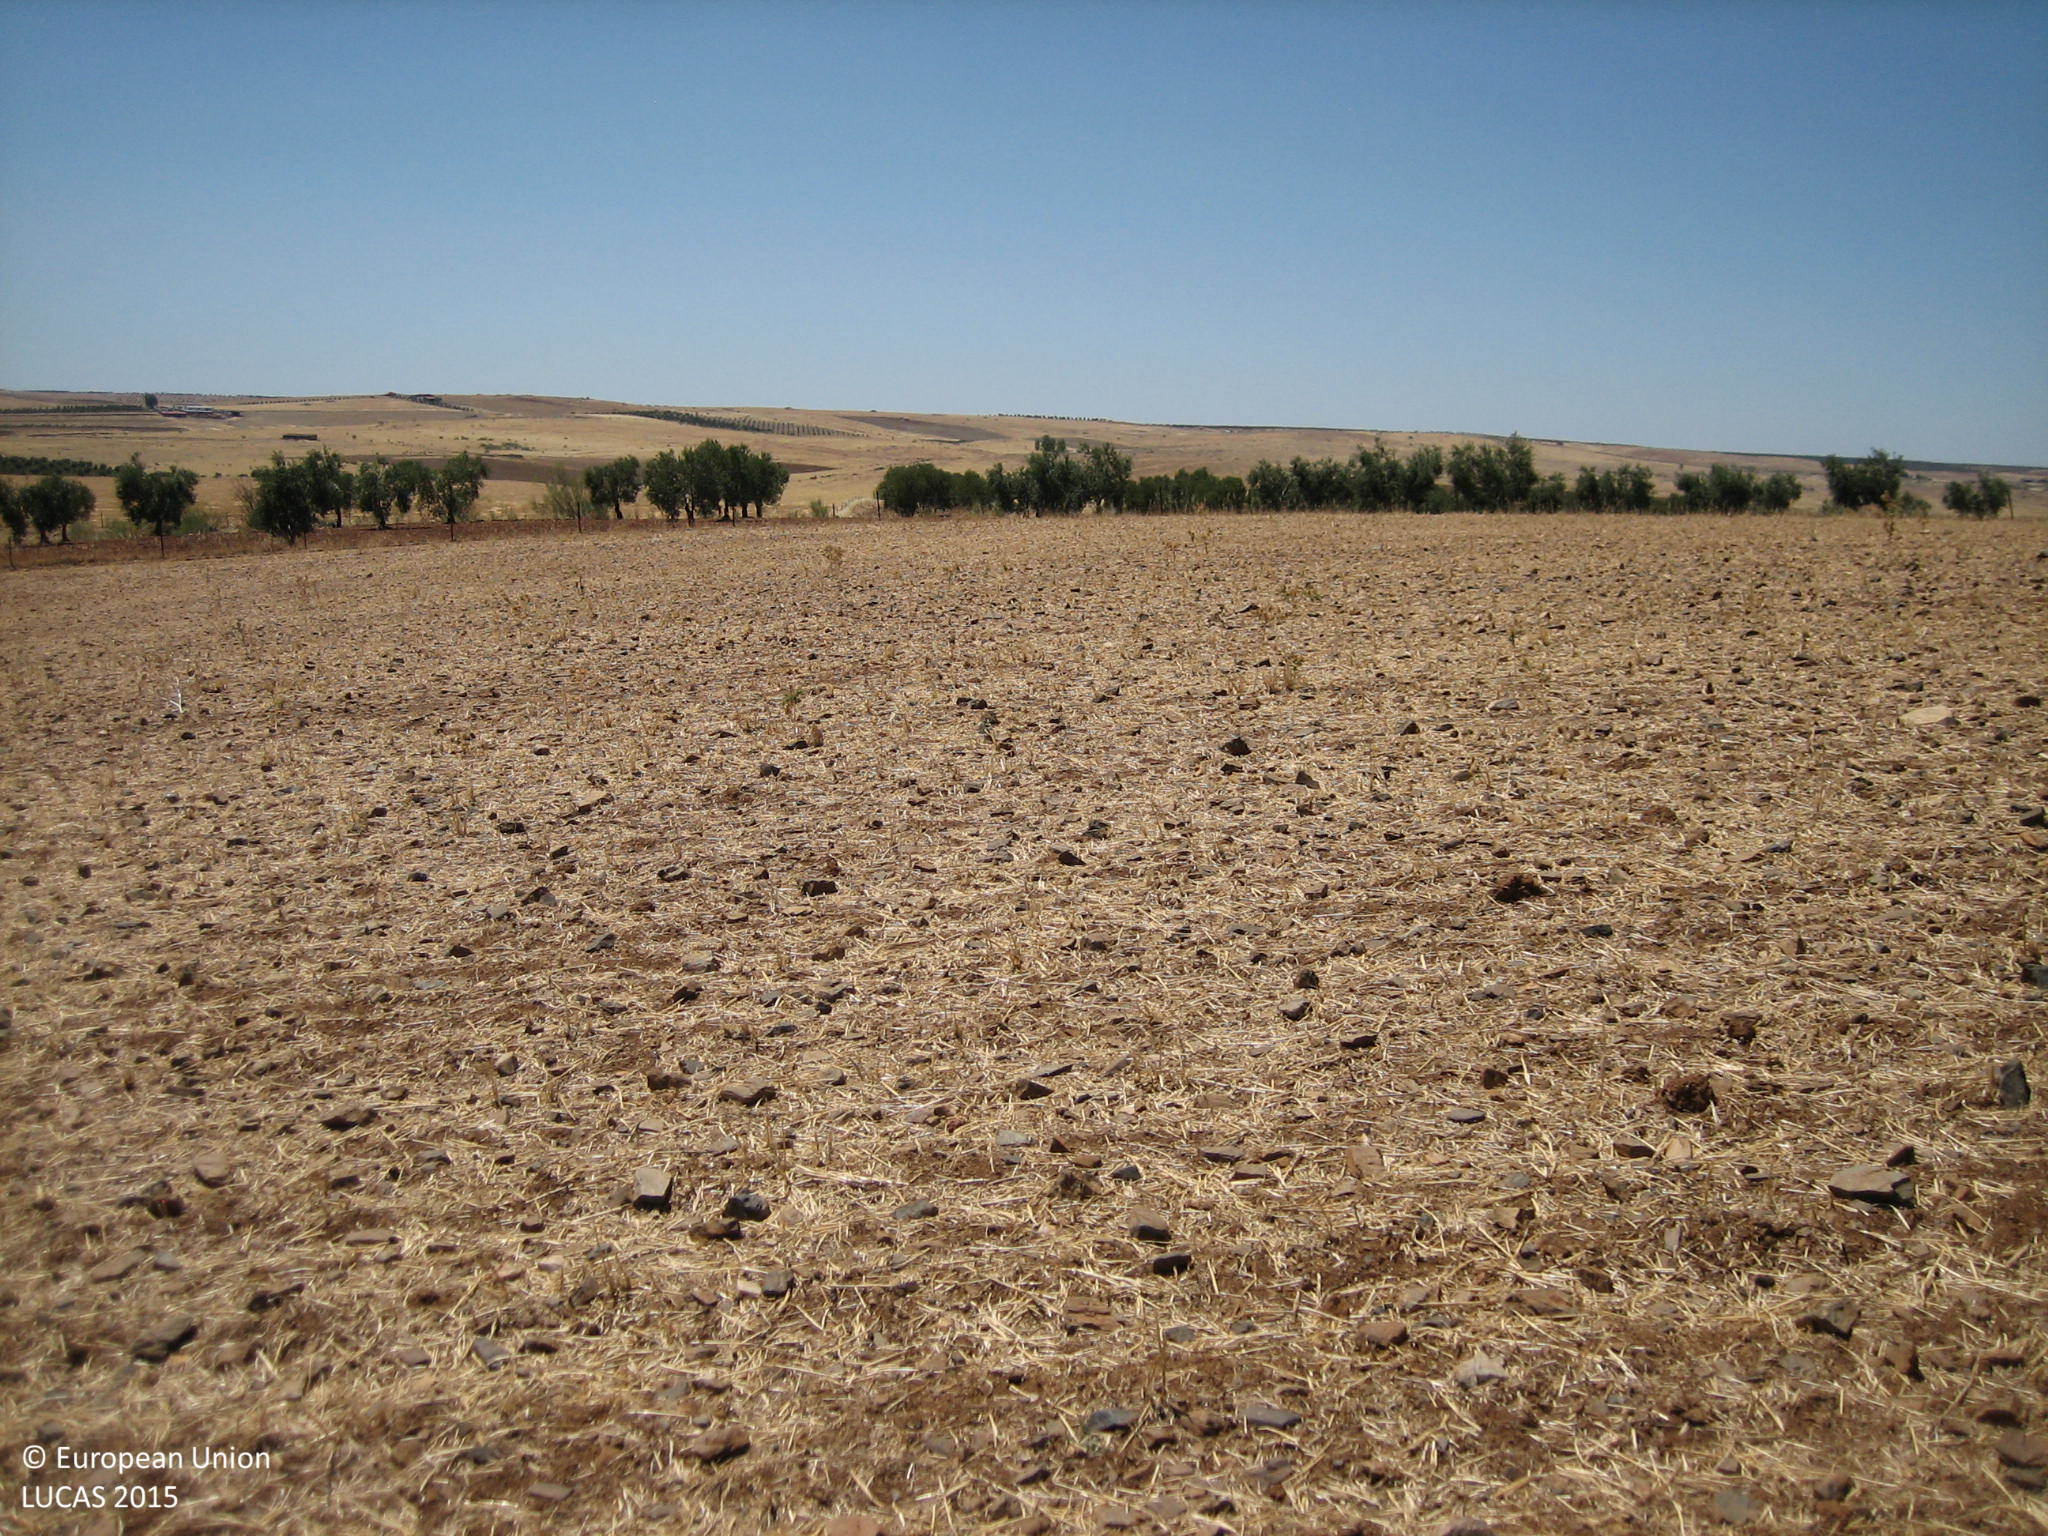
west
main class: Cropland
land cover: Oats
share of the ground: < 10 %
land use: Agriculture (excluding fallow land and kitchen gardens)
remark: Harvested field
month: July
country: ES
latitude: 38.5832
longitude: -6.1775
